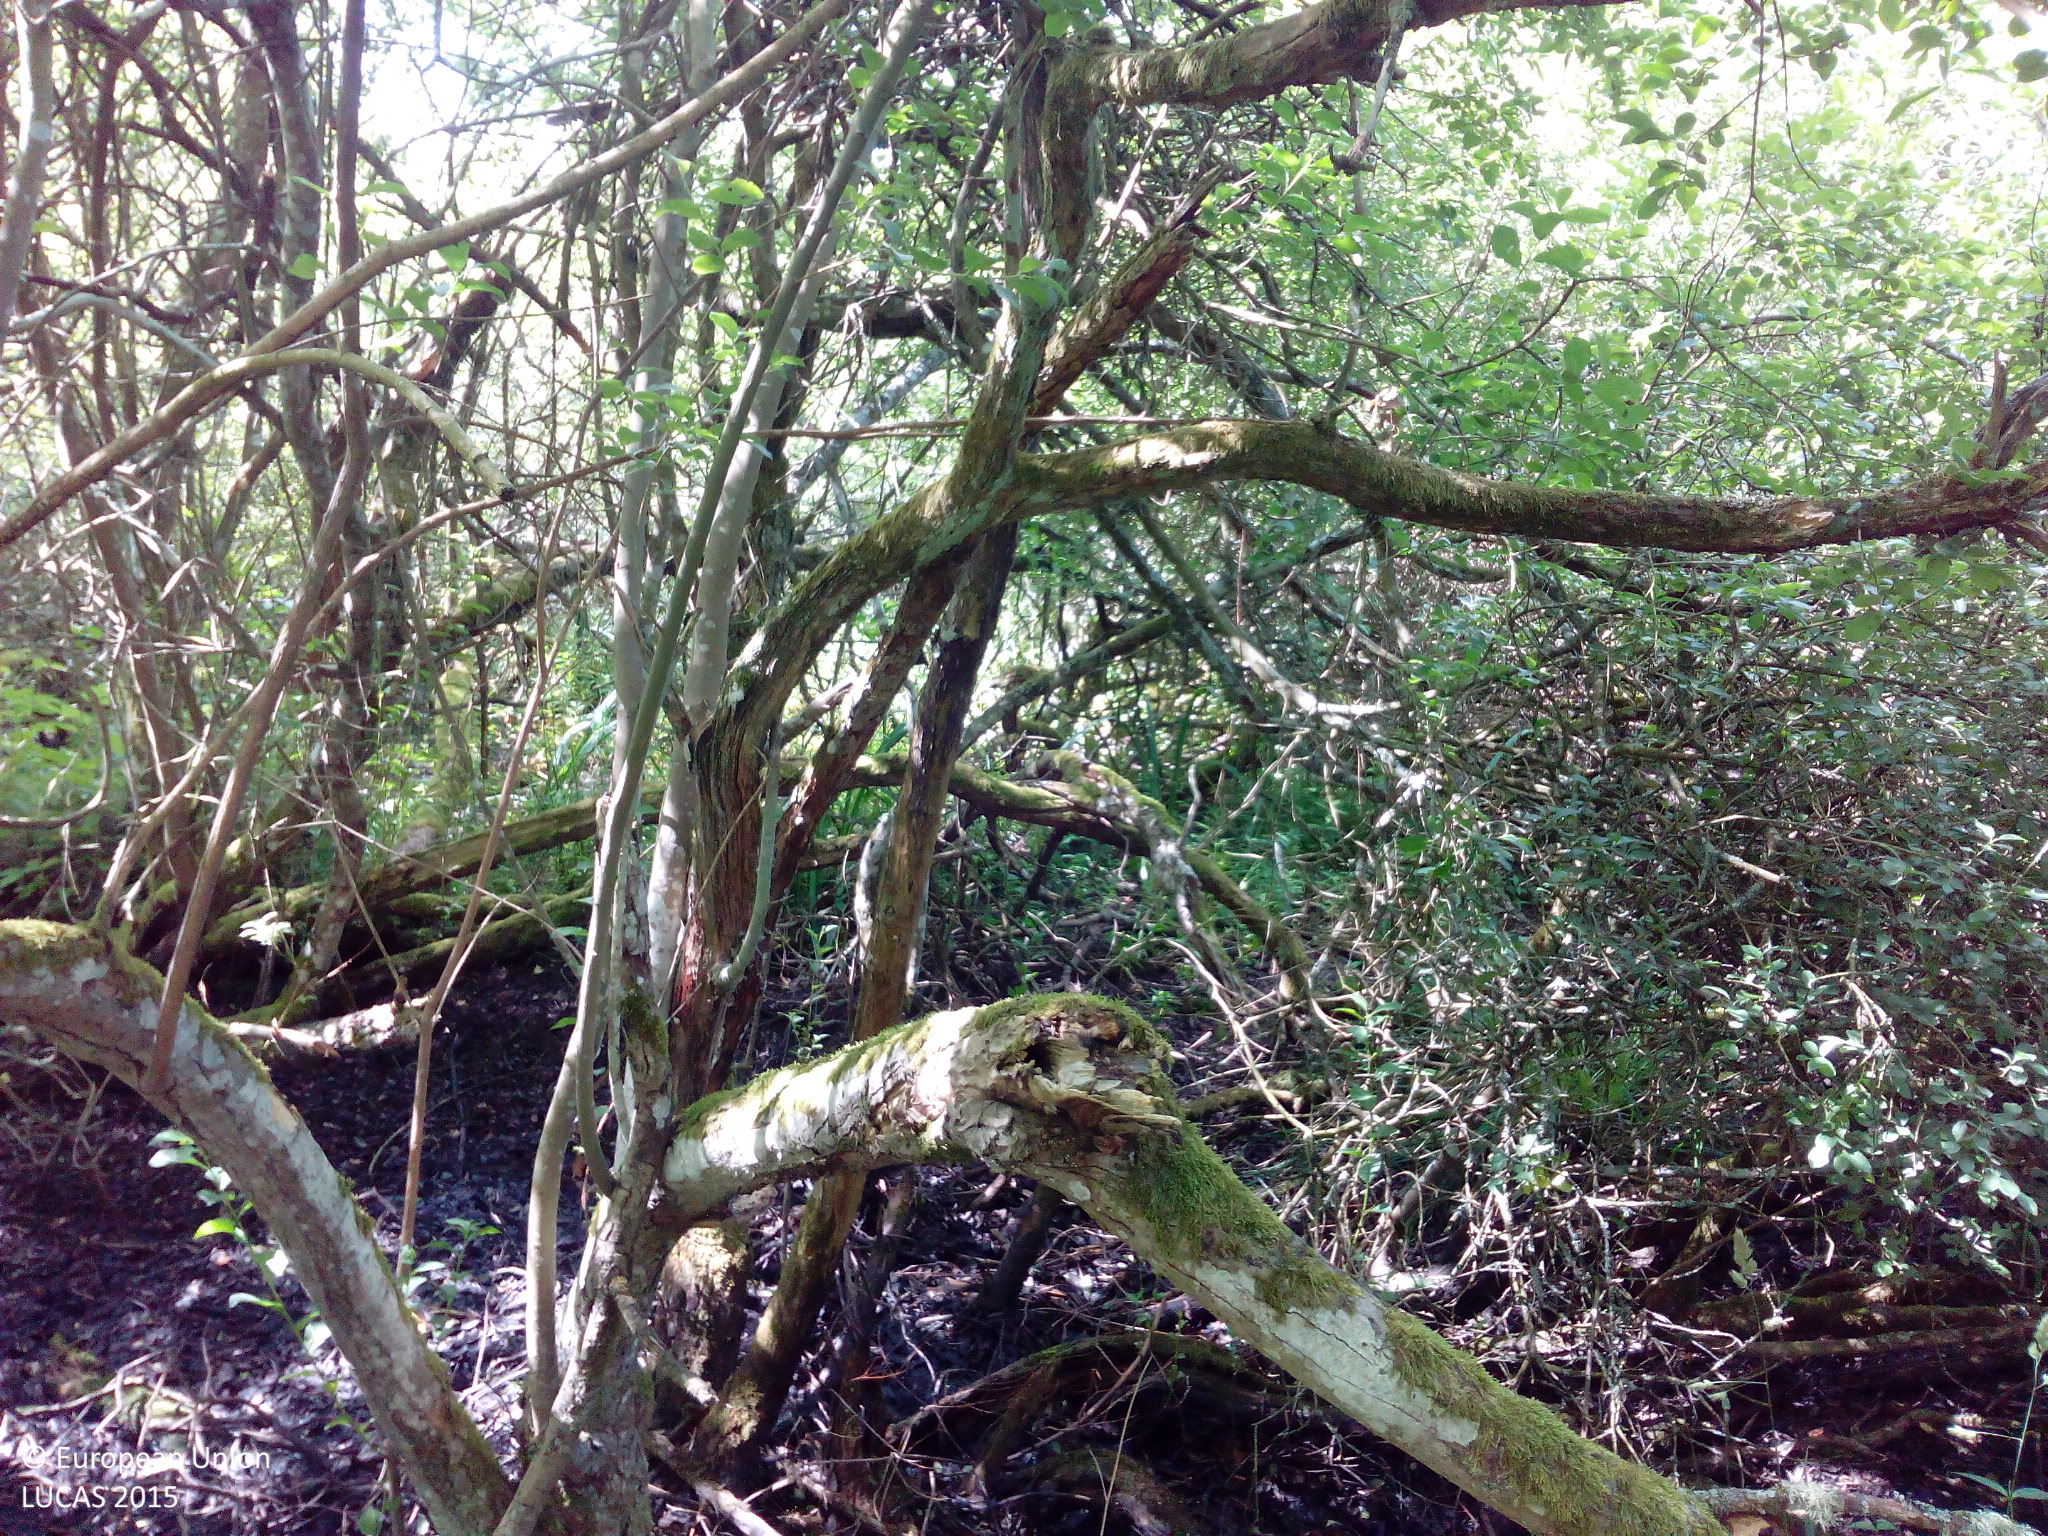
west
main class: Woodland
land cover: Broadleaved woodland
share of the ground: > 75 %
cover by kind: broadleaved forest trees 60 %, herbaceous plants 30 %, shrubs 10 %
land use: Semi-natural and natural areas not in use
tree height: < 5 m
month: July
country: DK
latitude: 56.0093
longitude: 12.0670
